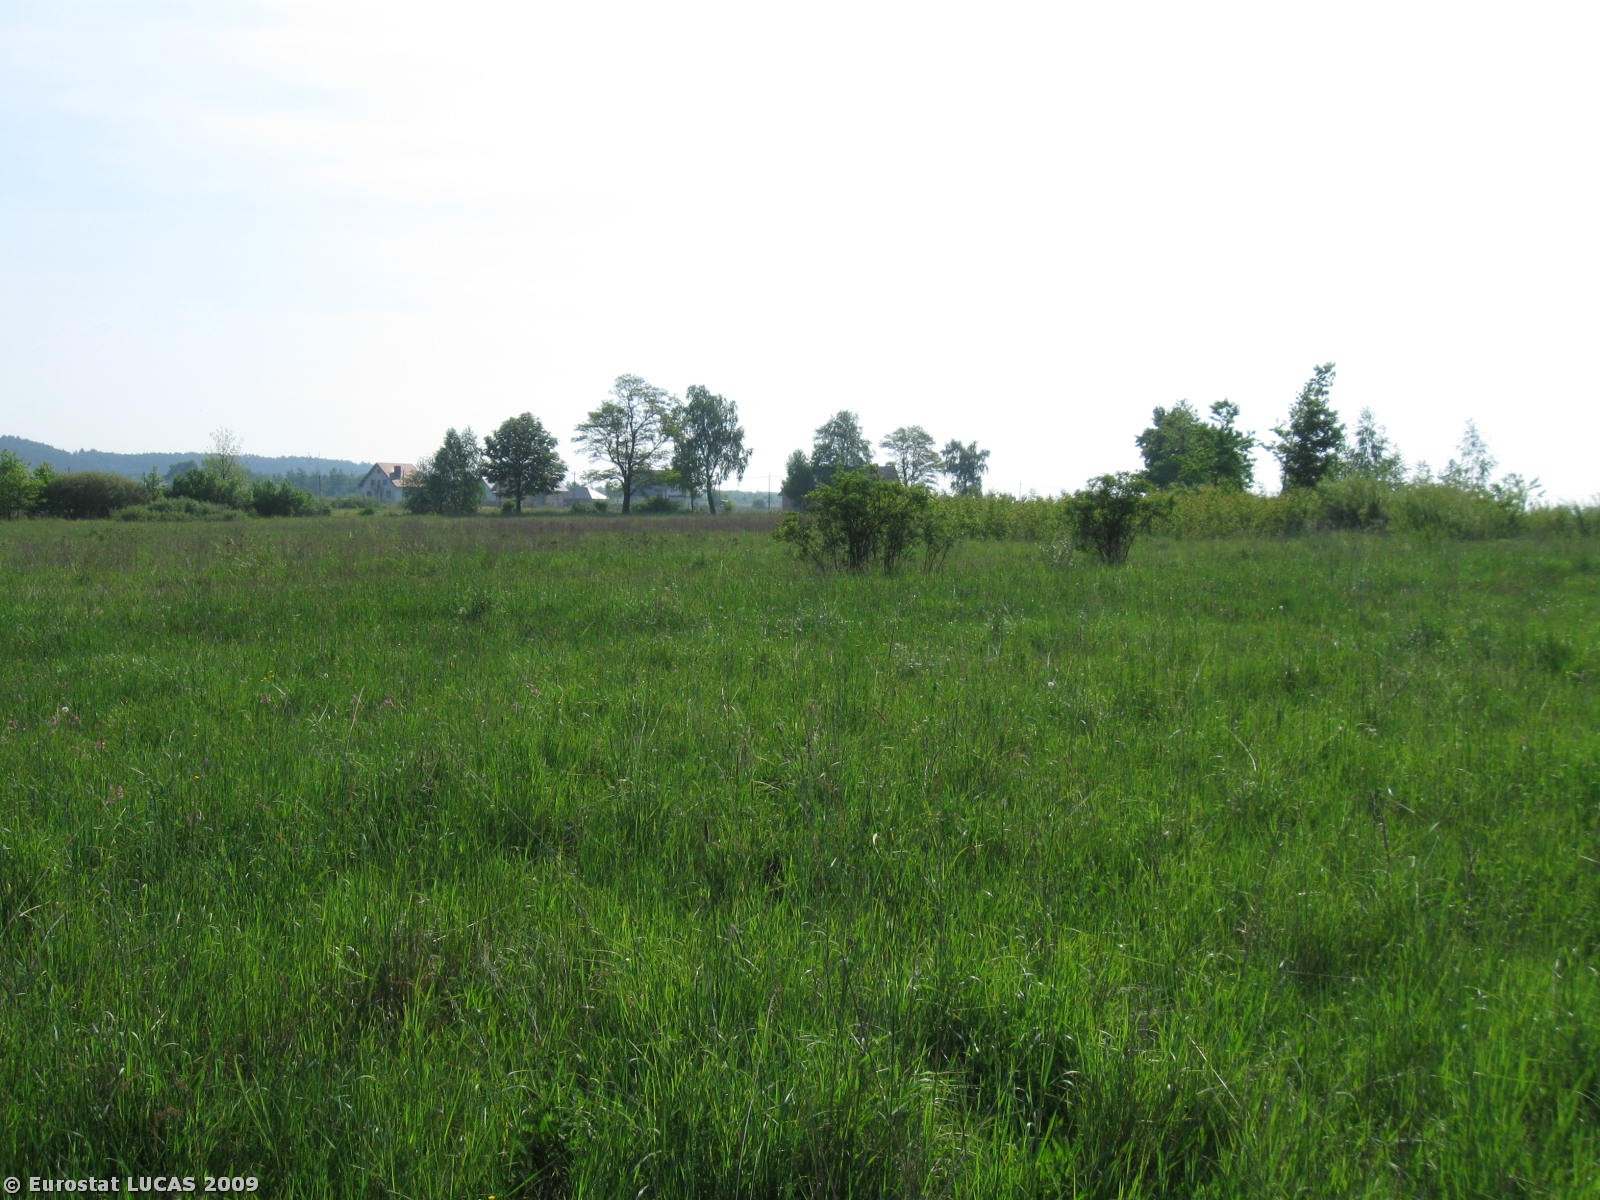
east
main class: Grassland
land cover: Grassland without tree/shrub cover
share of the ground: > 75 %
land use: Unused
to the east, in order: Grassland without tree/shrub cover; Ditches and canals; Single bushes/trees; Grassland without tree/shrub cover; Lines of trees; Paved roads, cycling and walking lanes; Grassland without tree/shrub cover
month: May
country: PL
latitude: 50.8098
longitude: 20.4400
